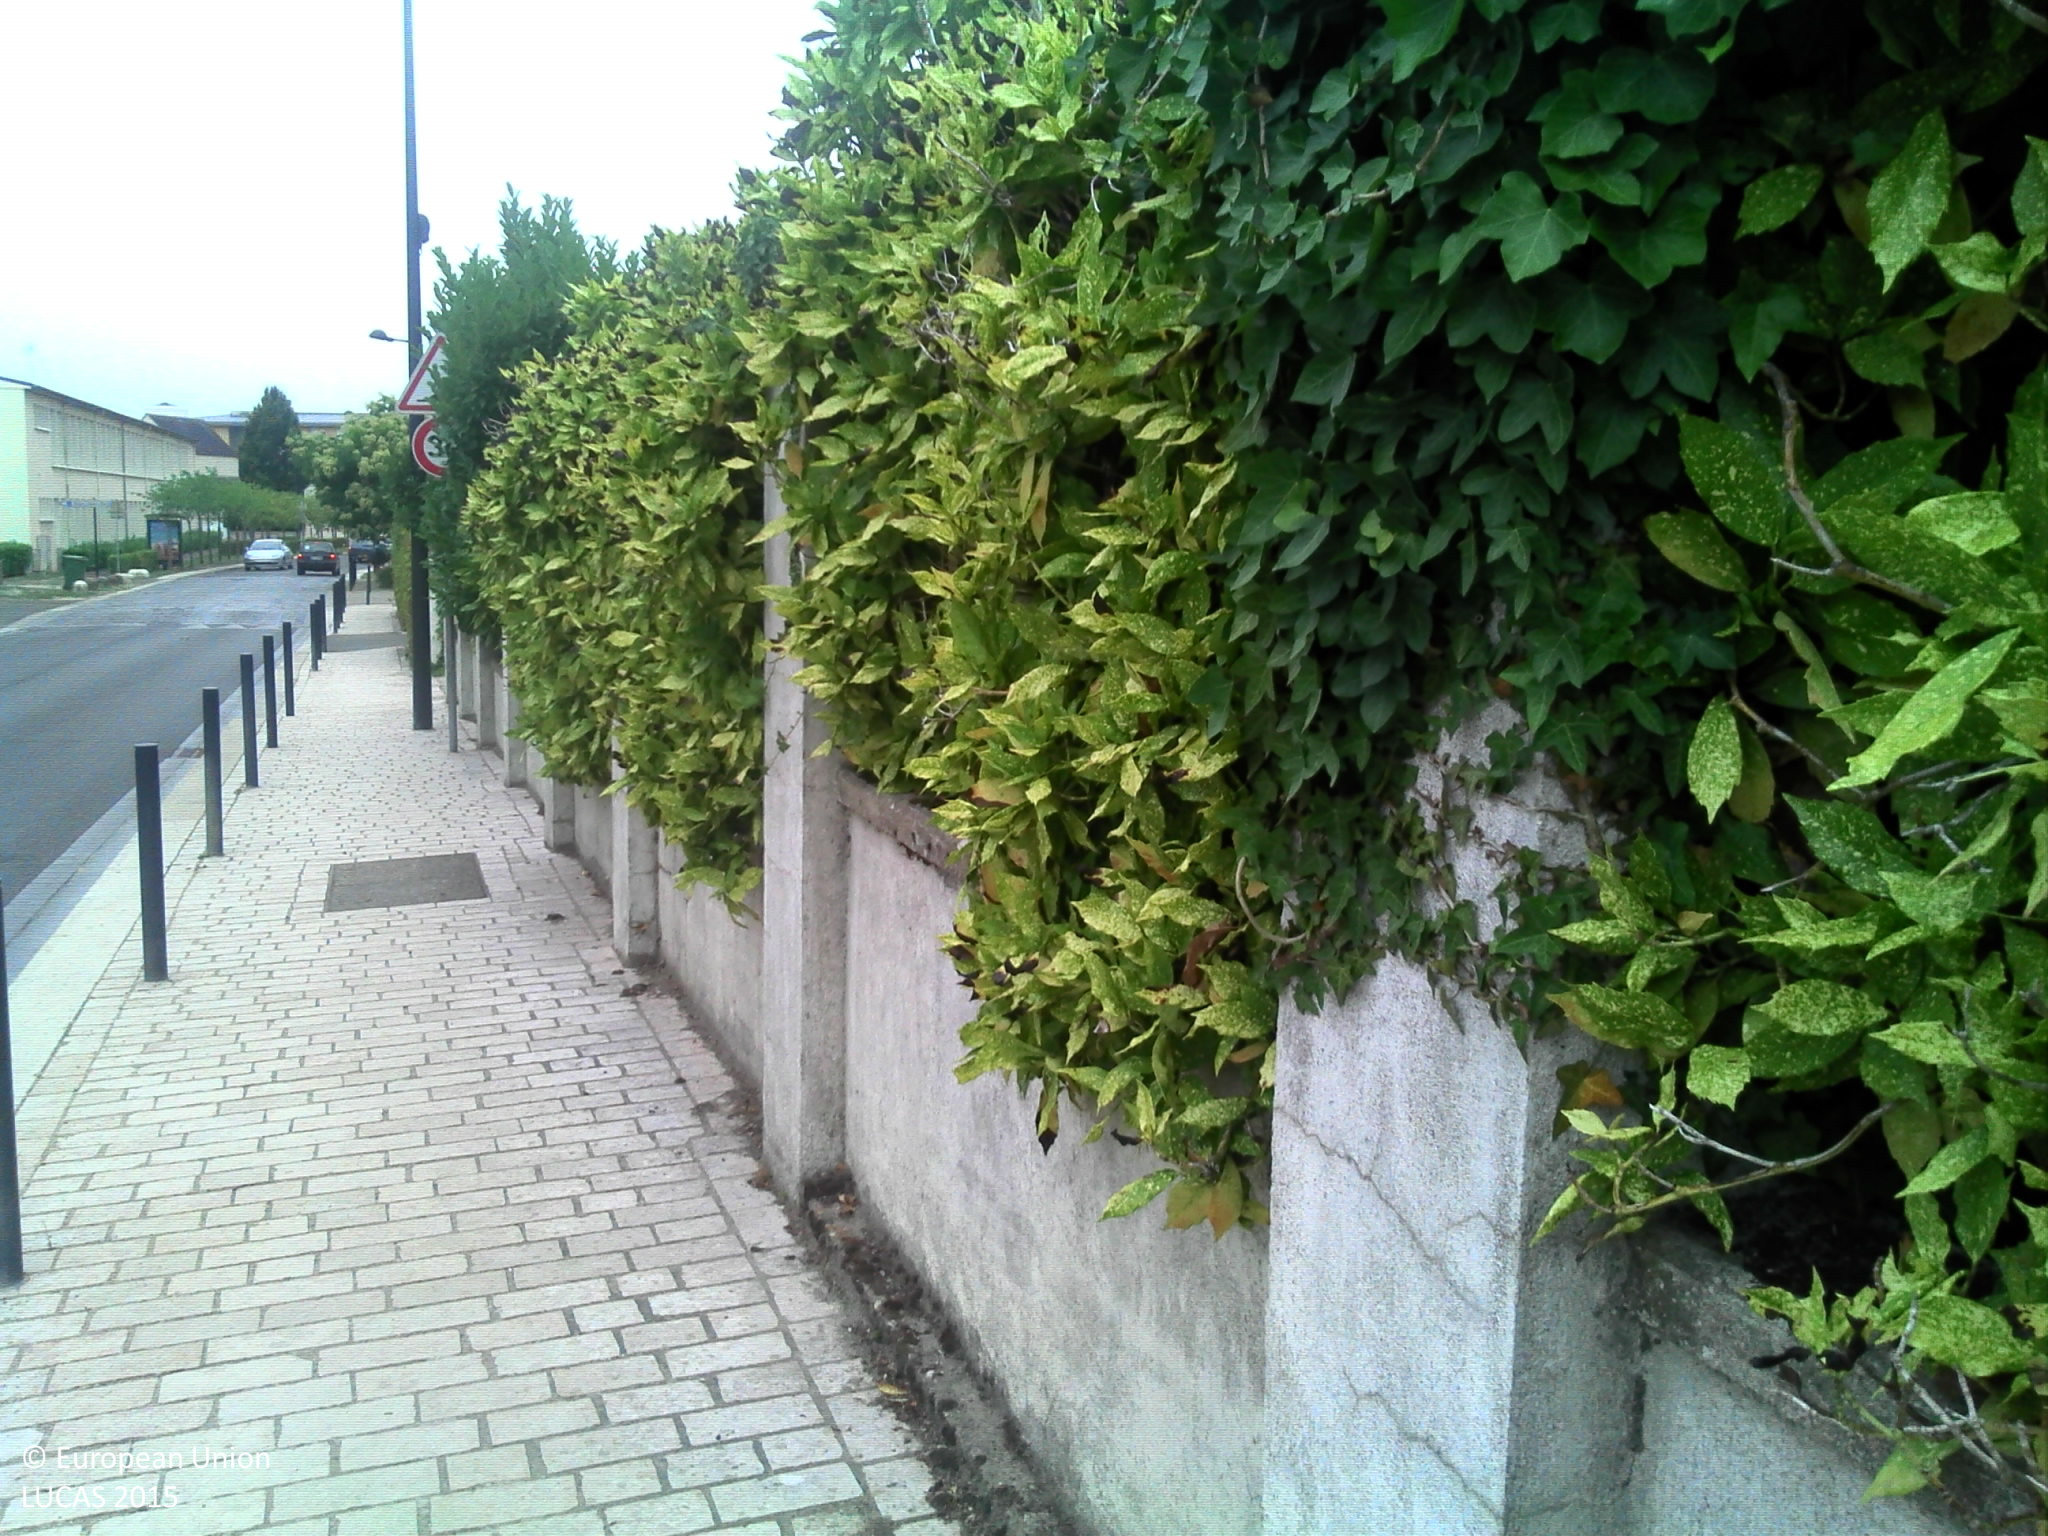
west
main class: Woodland
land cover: Broadleaved woodland
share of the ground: > 75 %
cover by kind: broadleaved forest trees 100 %
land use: Residential
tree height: > 5 m
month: July
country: FR
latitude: 47.9125
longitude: 1.9732
